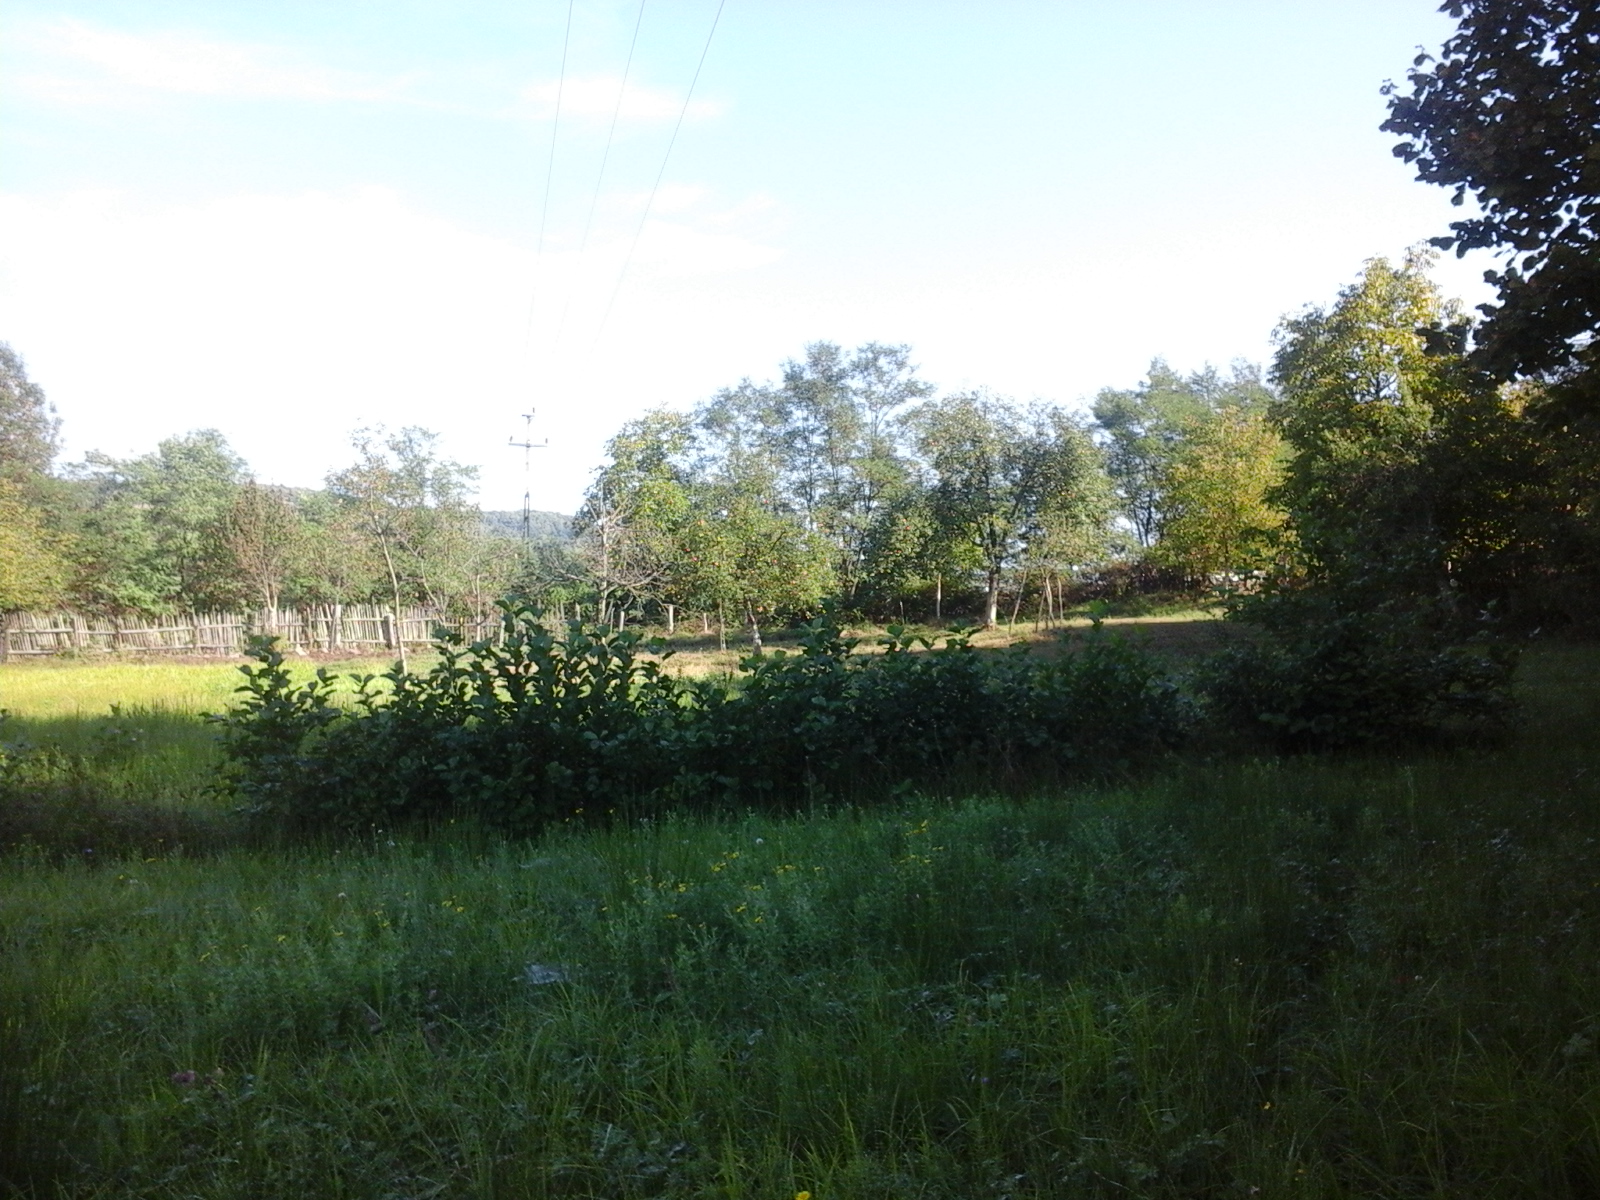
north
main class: Woodland
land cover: Broadleaved woodland
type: exotic forest
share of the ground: > 75 %
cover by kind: broadleaved forest trees 100 %
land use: Forestry
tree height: > 5 m
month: September
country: RO
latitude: 46.6169
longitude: 22.4966
